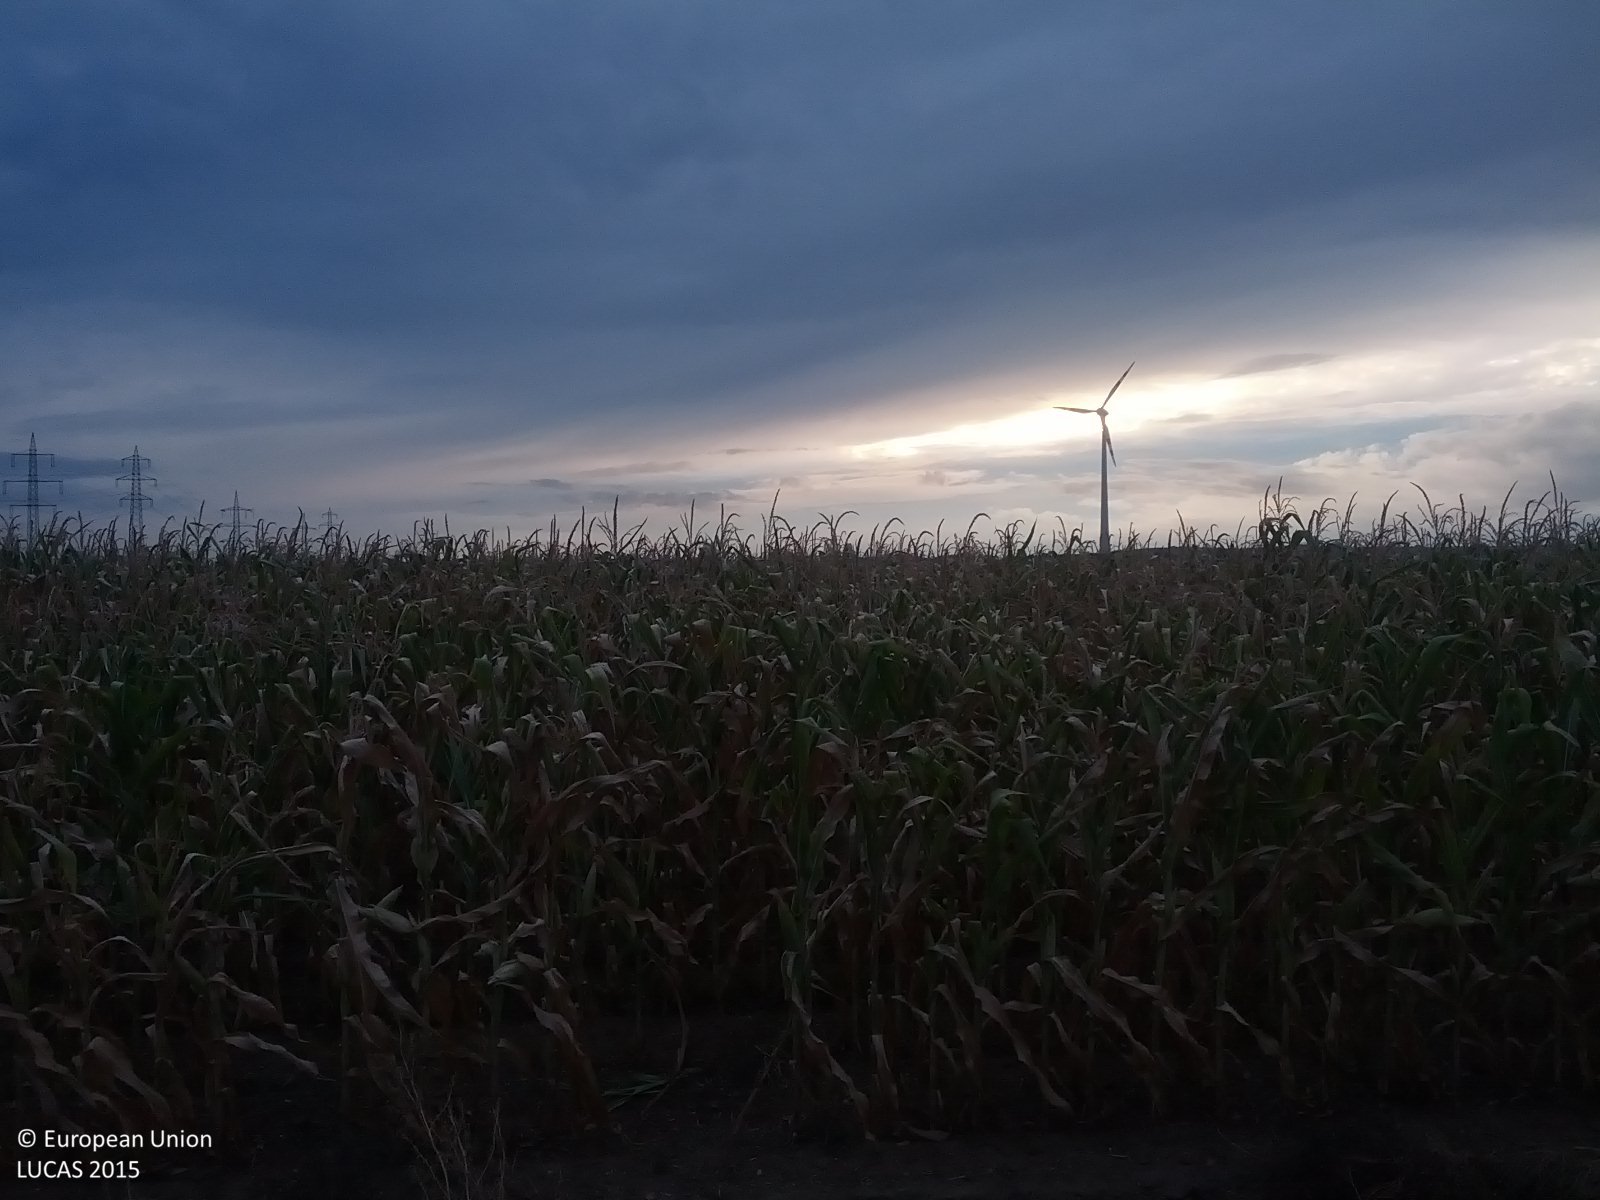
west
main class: Cropland
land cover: Other root crops
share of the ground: < 10 %
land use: Agriculture (excluding fallow land and kitchen gardens)
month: July
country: AT
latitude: 48.3552
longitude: 16.5241
